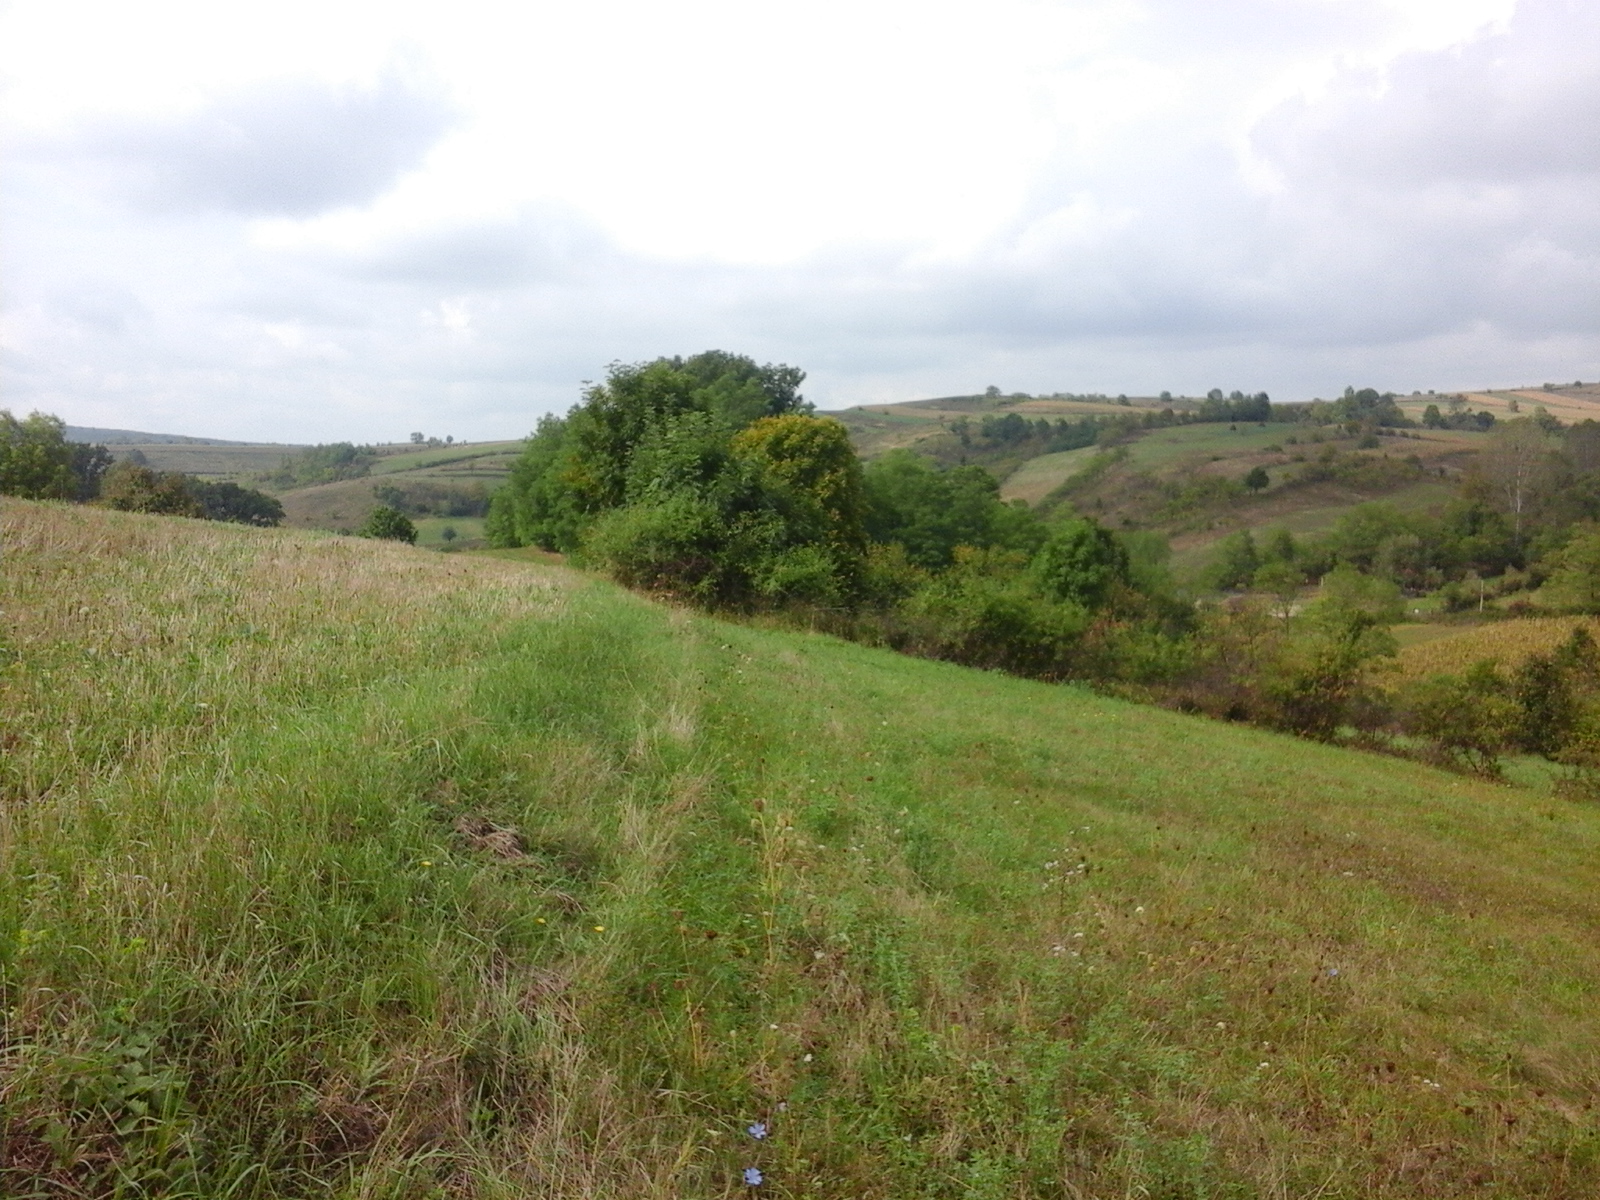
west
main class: Grassland
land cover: Grassland without tree/shrub cover
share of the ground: > 75 %
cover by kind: herbaceous plants 100 %
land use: Agriculture (excluding fallow land and kitchen gardens)
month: September
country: RO
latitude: 46.7029
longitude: 22.2251
